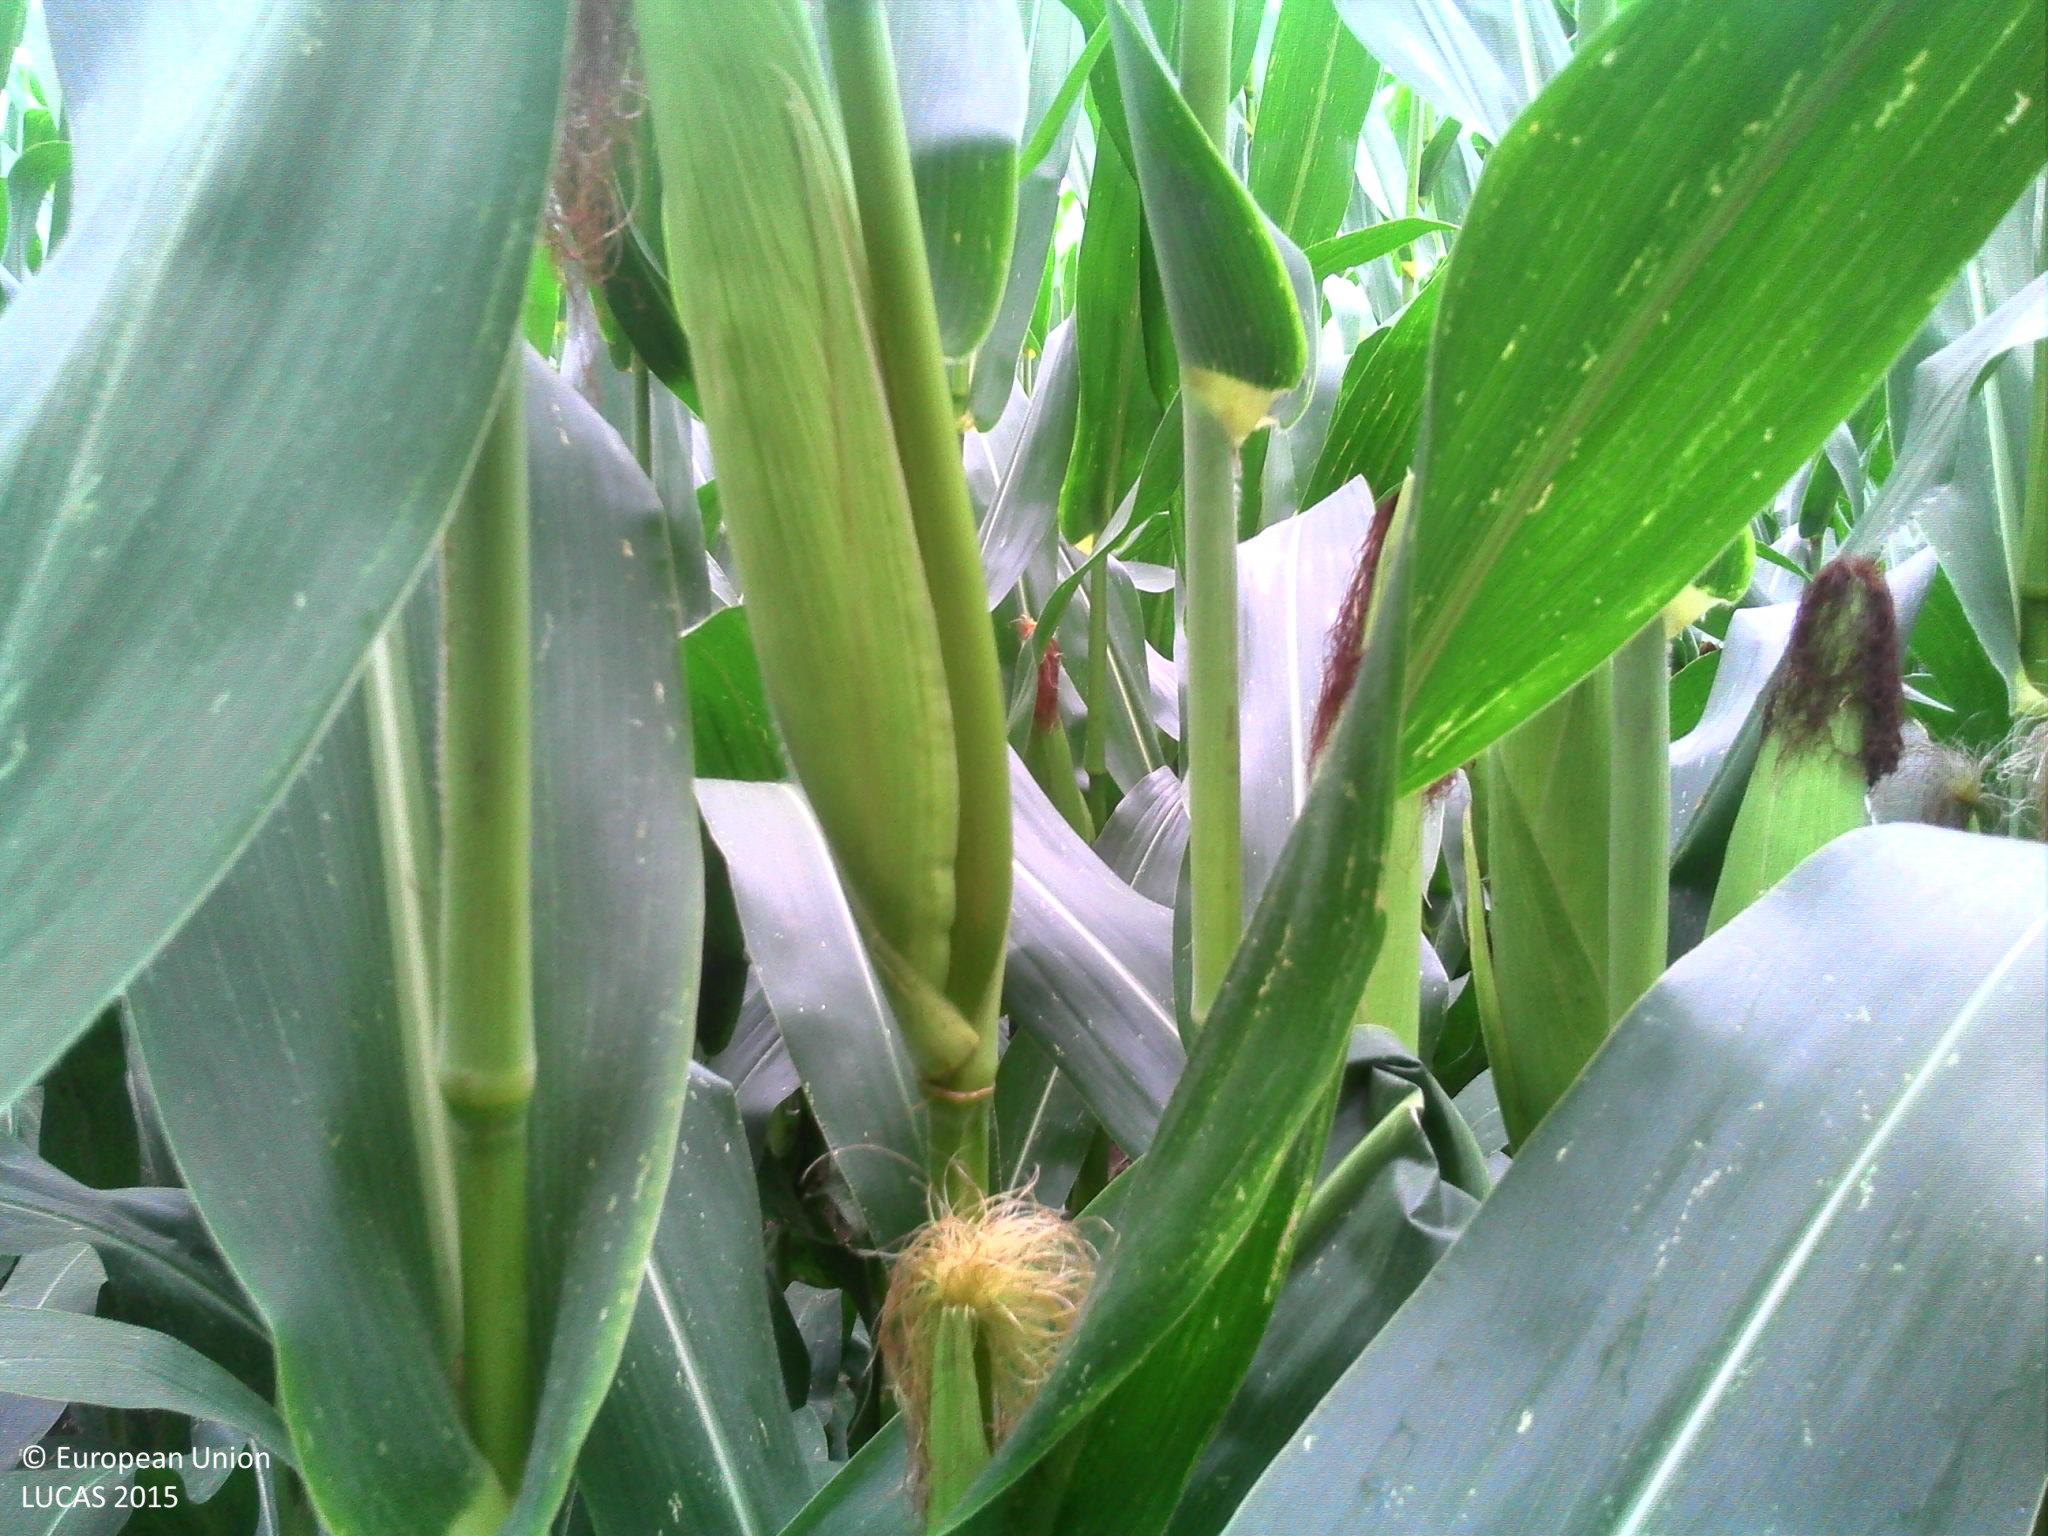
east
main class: Cropland
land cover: Maize
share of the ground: > 75 %
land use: Agriculture (excluding fallow land and kitchen gardens)
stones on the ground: 10 - 25 %
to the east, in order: Maize; Electric lines; Maize; Broadleaved woodland; Maize; Grassland without tree/shrub cover
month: July
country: FR
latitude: 47.9362
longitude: 2.0502
